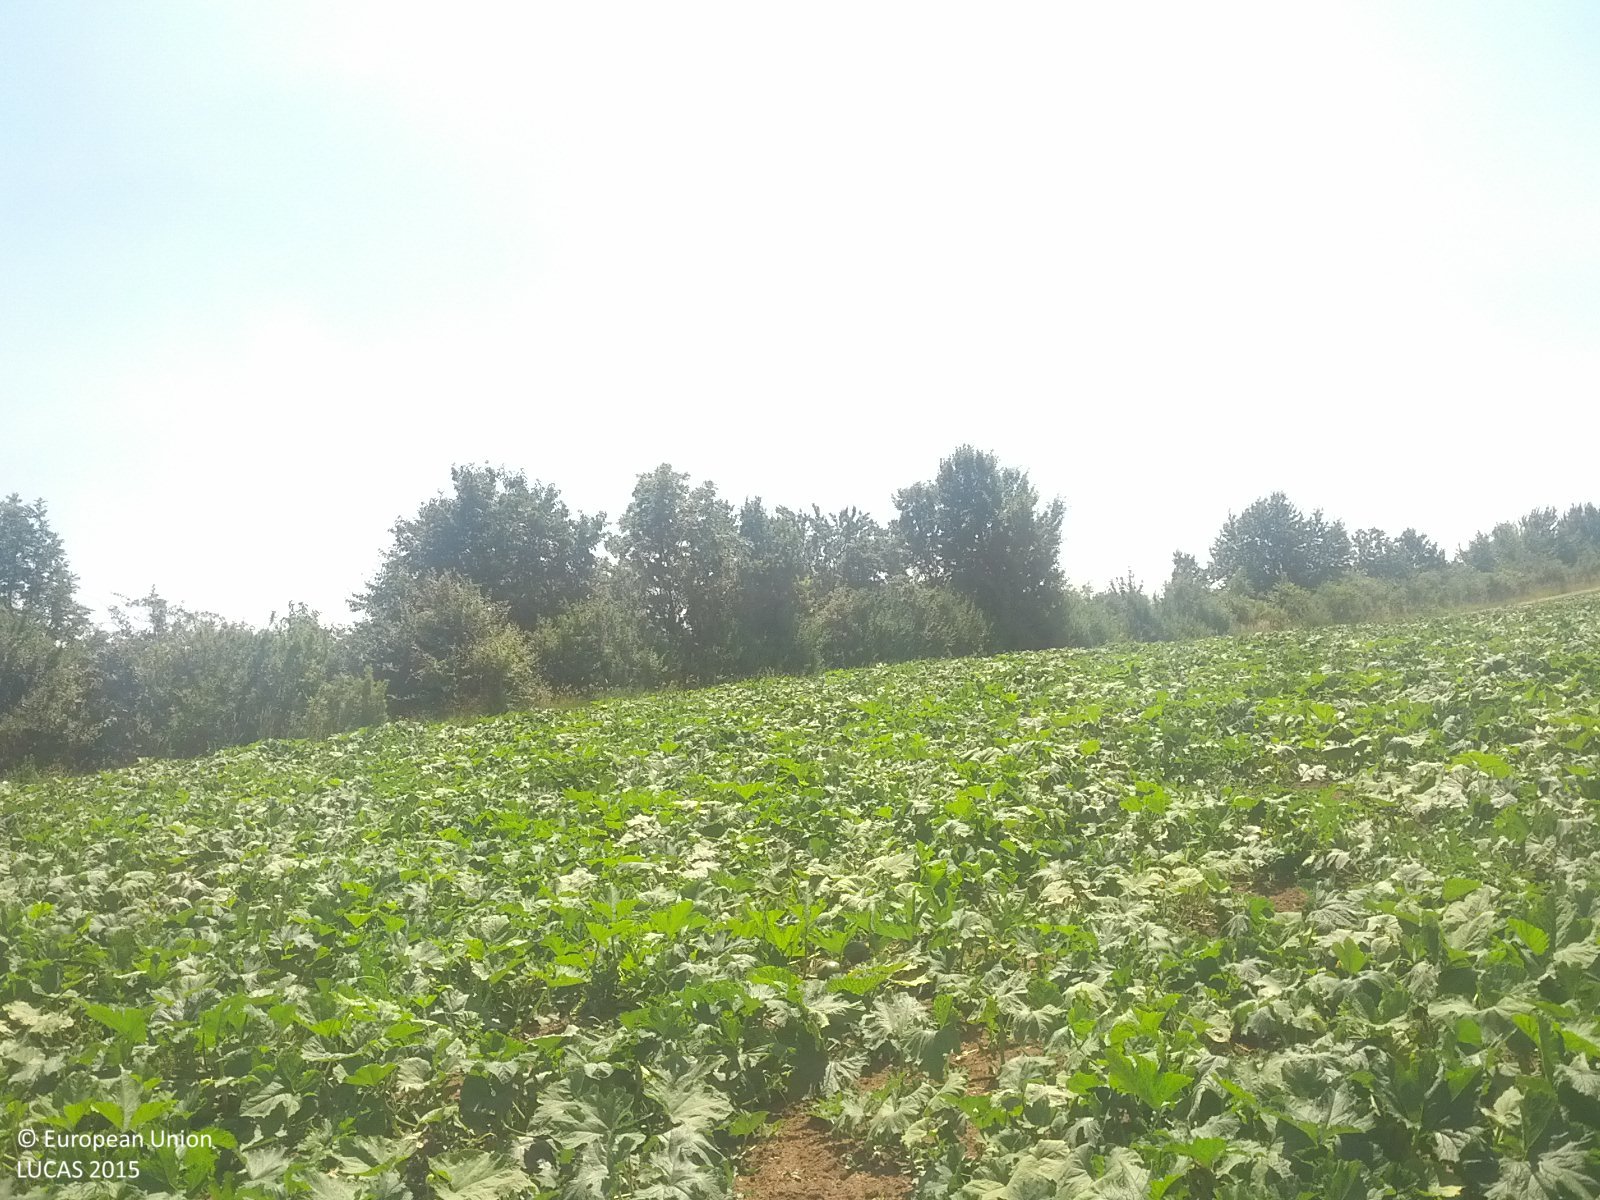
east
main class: Cropland
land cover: Other fresh vegetables
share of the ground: > 75 %
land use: Agriculture (excluding fallow land and kitchen gardens)
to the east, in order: Other fresh vegetables; Shrubland with sparse tree cover; Grass margins; Tracks; Grass margins; Common wheat; Grass margins; Tracks; Grass margins; Common wheat
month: July
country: AT
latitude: 48.5327
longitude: 16.5744
